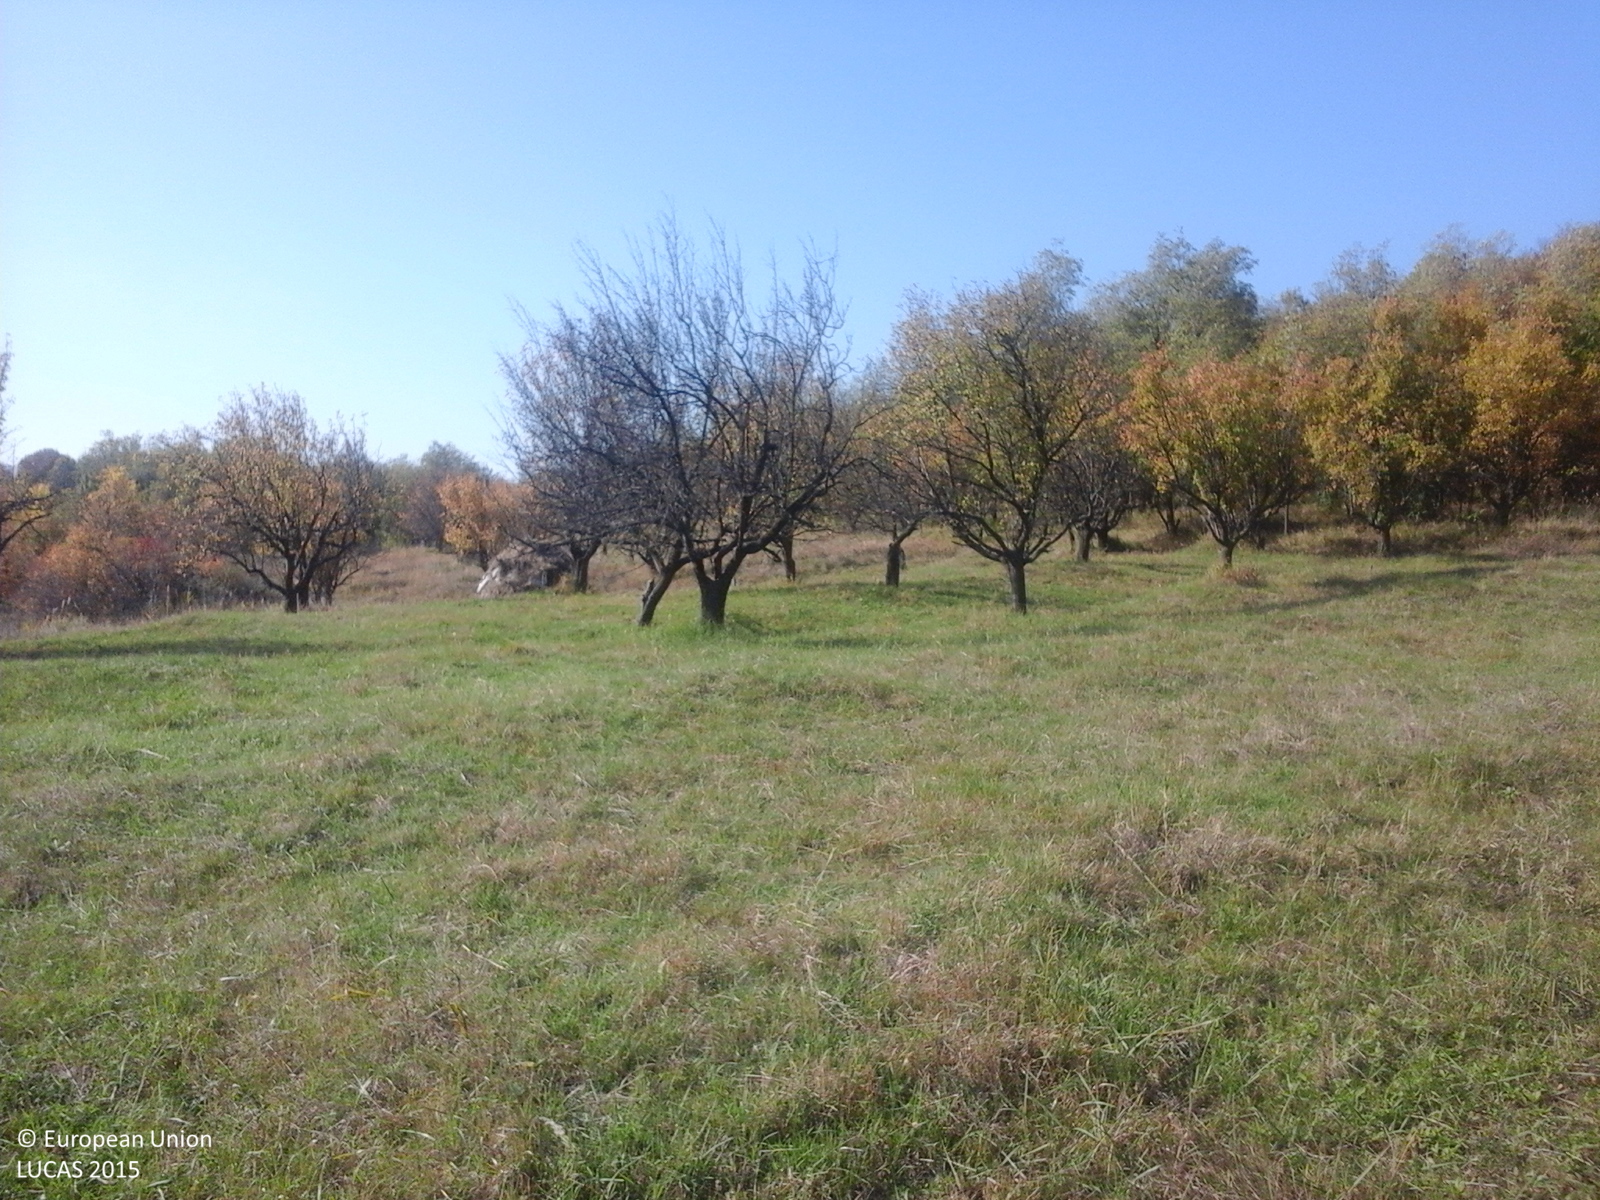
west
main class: Cropland
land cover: Other fruit trees and berries
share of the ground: > 75 %
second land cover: Grassland without tree/shrub cover
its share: > 75 %
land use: Agriculture (excluding fallow land and kitchen gardens)
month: October
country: RO
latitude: 45.3053
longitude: 26.5650
